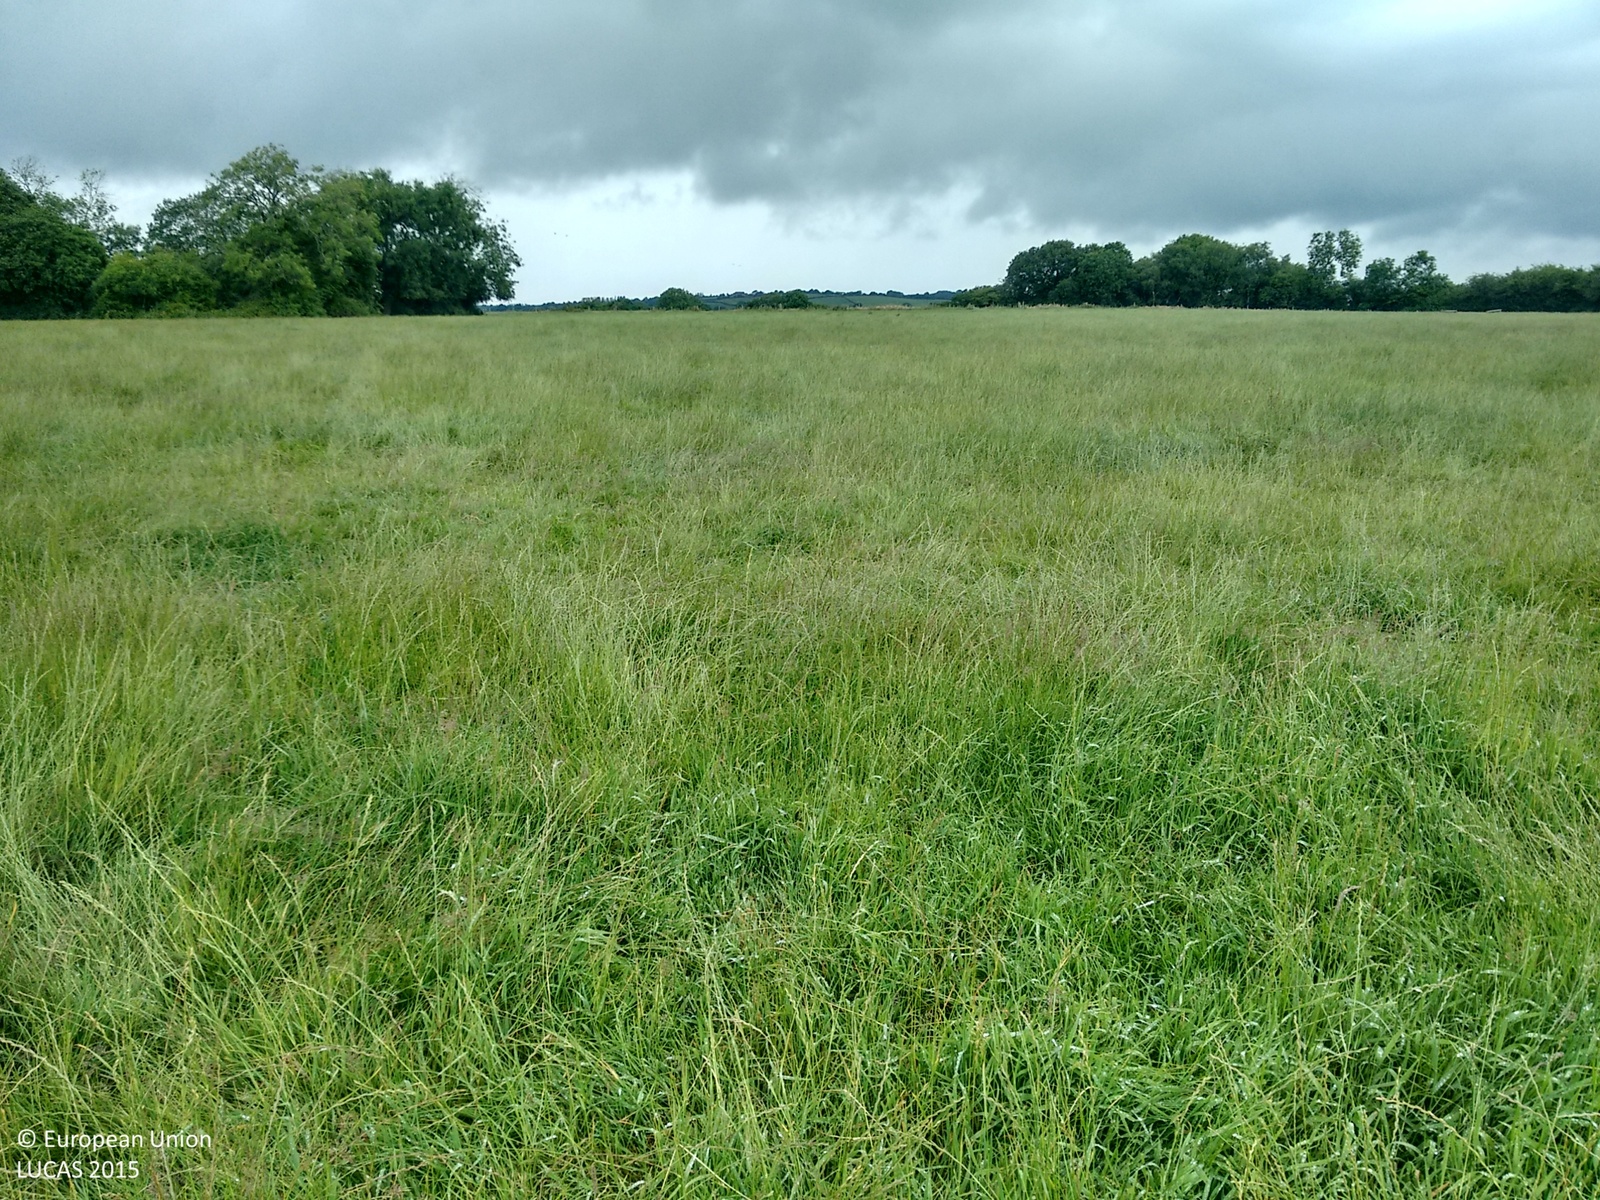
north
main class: Grassland
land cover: Grassland without tree/shrub cover
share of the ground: > 75 %
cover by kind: herbaceous plants 100 %
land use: Agriculture (excluding fallow land and kitchen gardens)
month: July
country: GB
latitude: 52.9672
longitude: -2.3471
